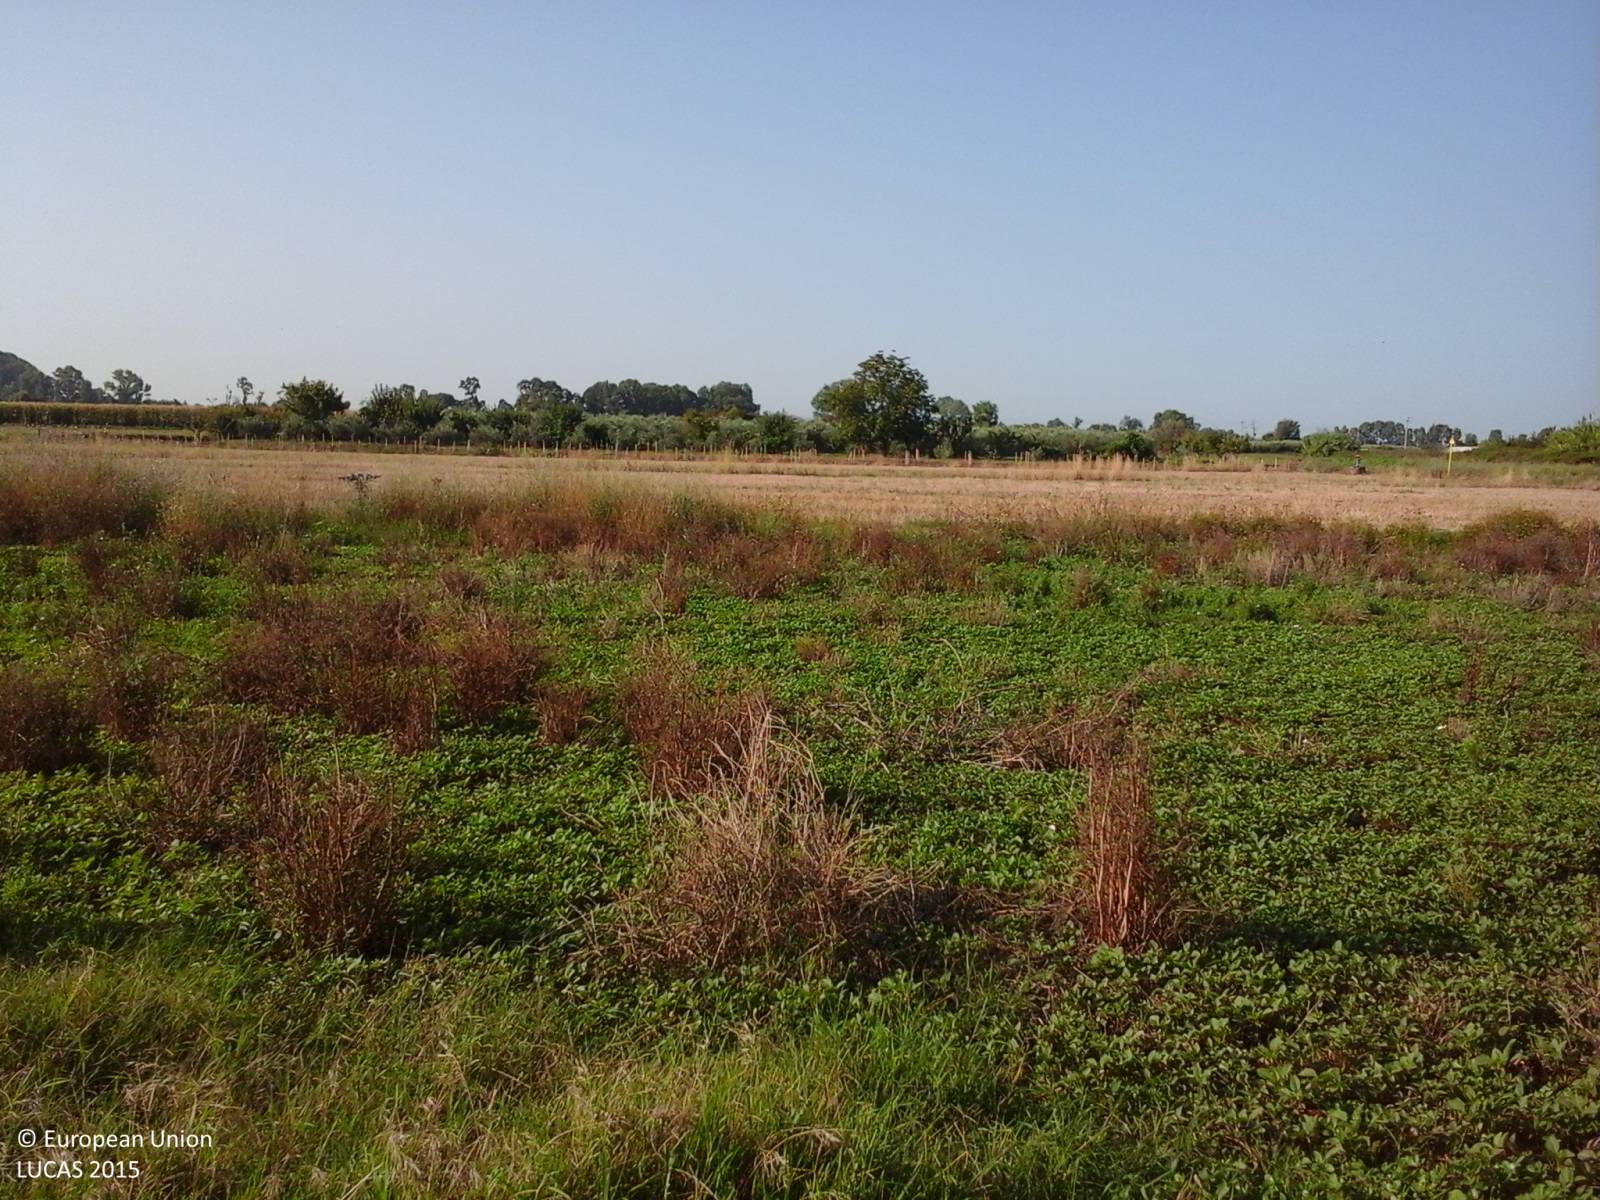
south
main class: Cropland
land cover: Olive groves
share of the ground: > 75 %
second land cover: Spontaneously vegetated surfaces
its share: > 75 %
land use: Agriculture (excluding fallow land and kitchen gardens)
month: August
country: IT
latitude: 41.3321
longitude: 13.3680
